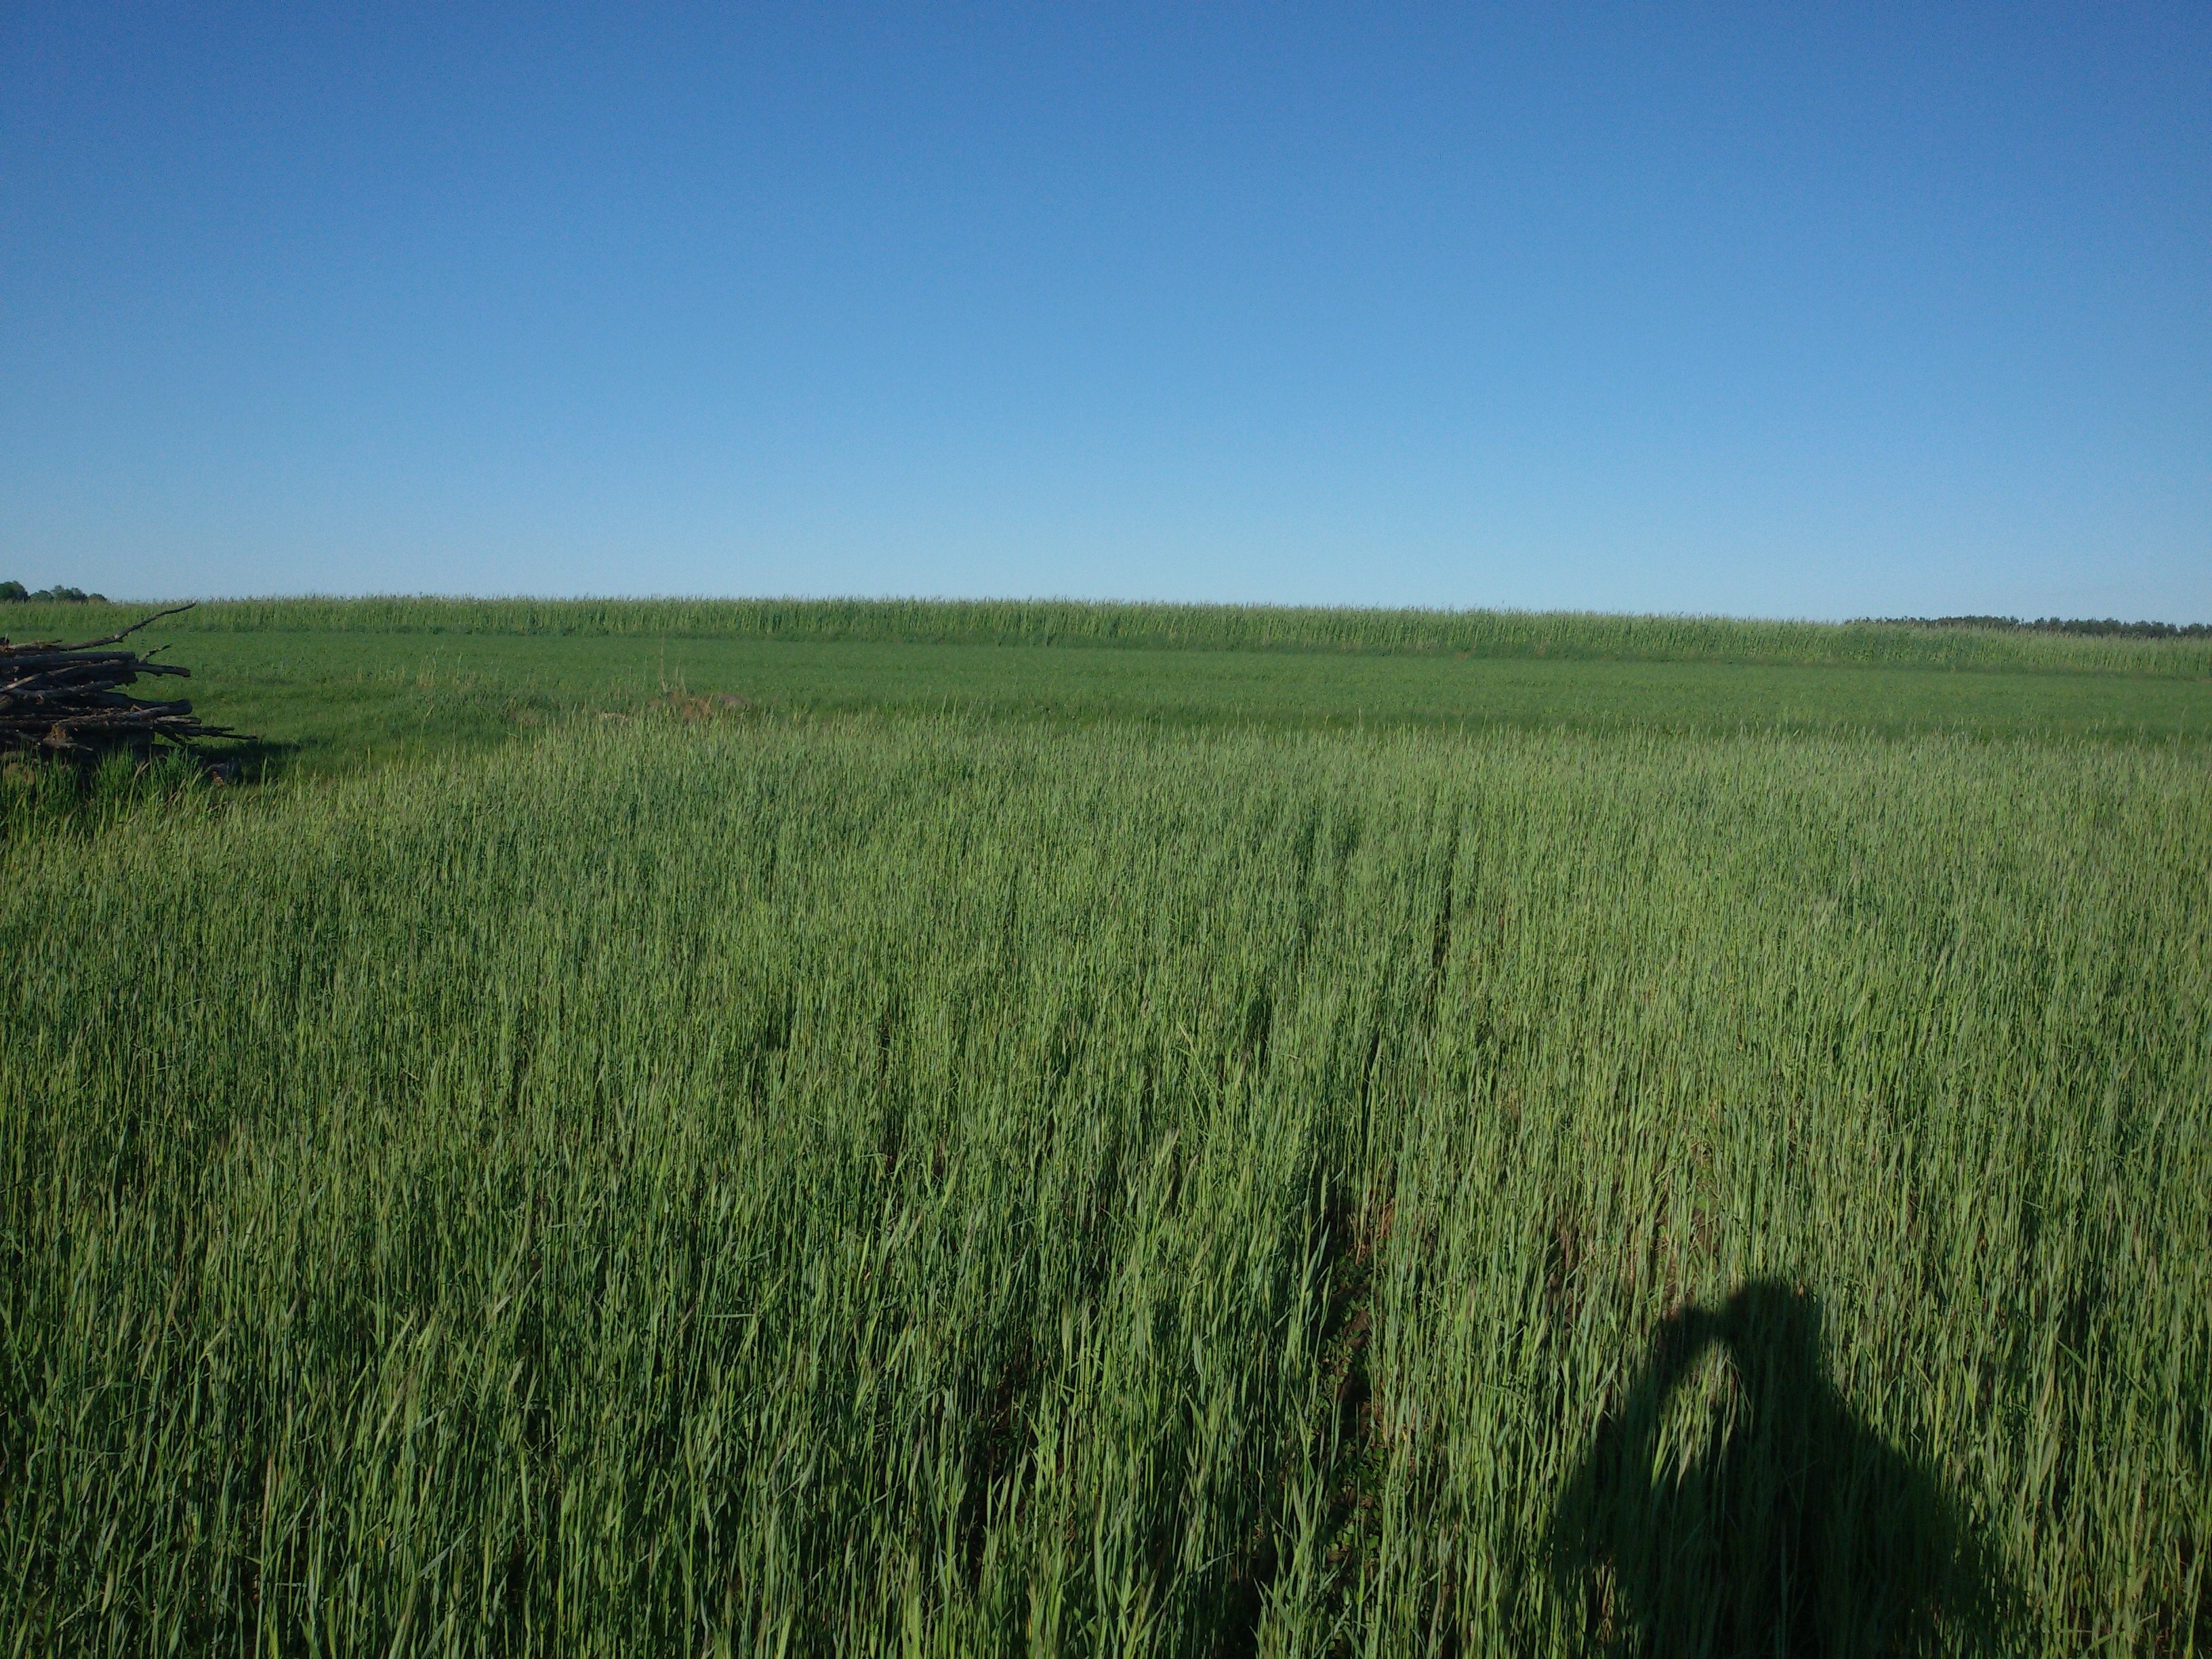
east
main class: Cropland
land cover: Rye
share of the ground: > 75 %
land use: Agriculture (excluding fallow land and kitchen gardens)
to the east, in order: Rye; Tracks; Barley; Maize; Triticale
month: May
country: PL
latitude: 53.4461
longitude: 17.1012
